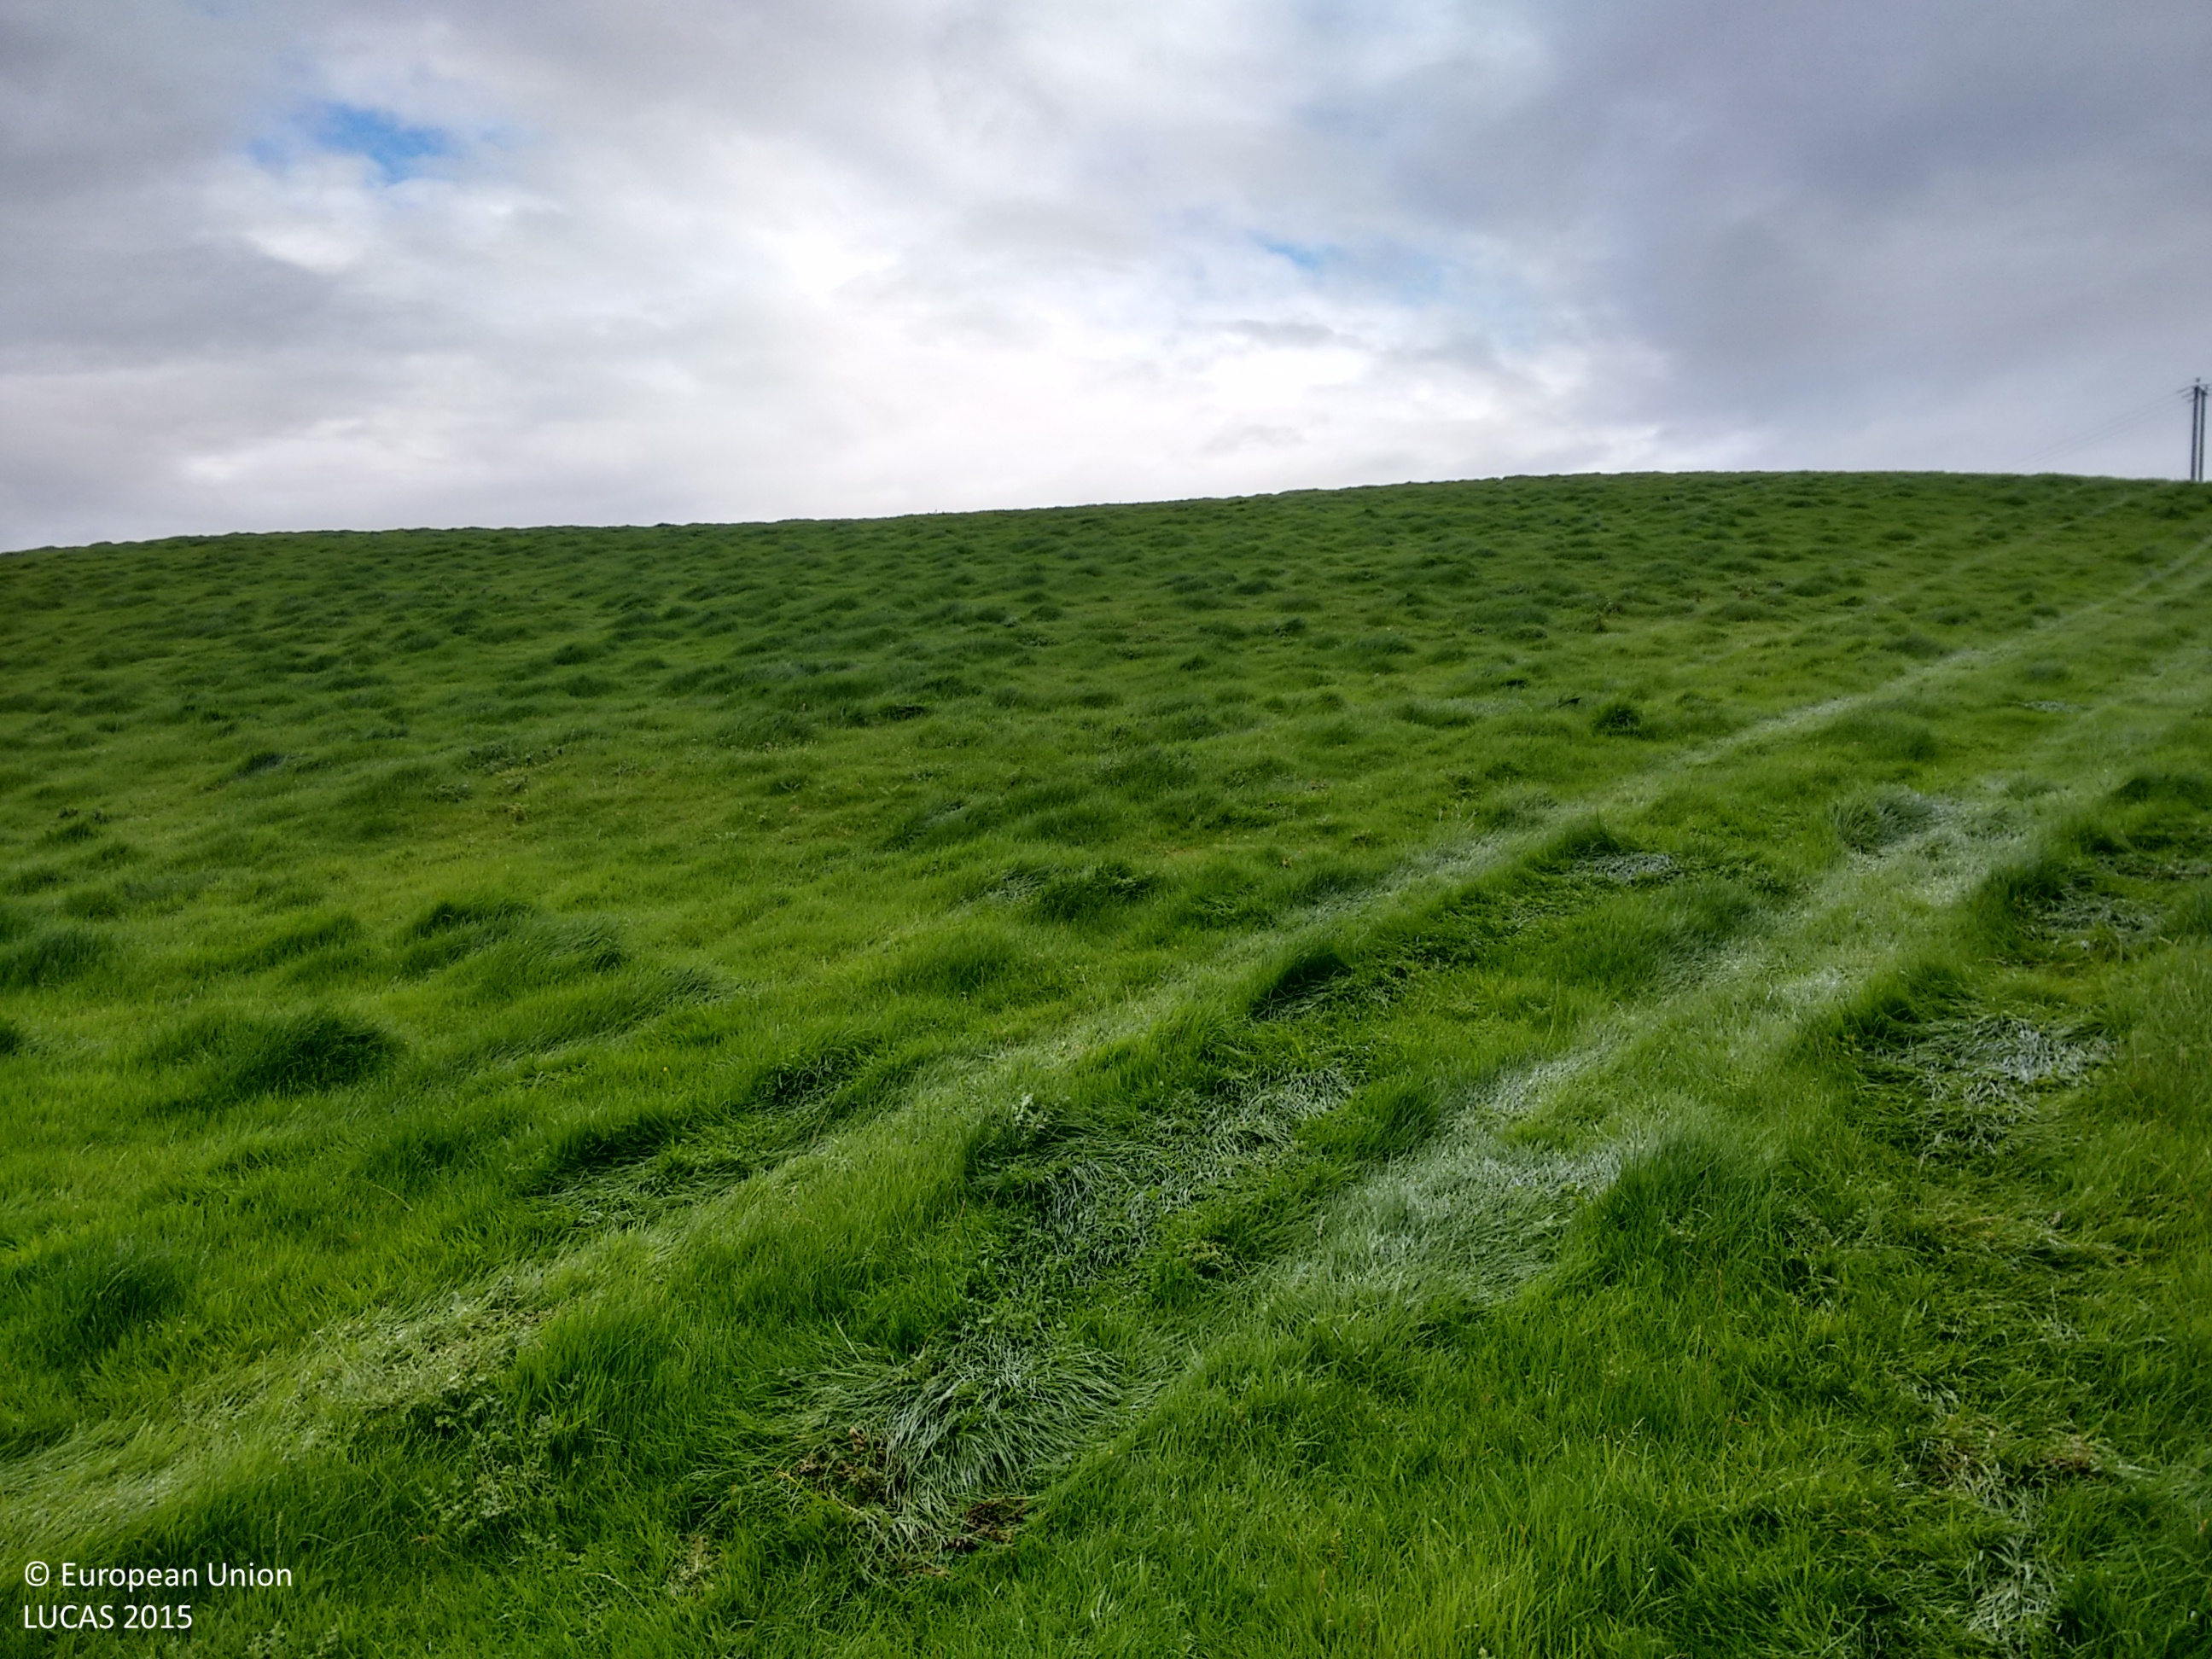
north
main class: Grassland
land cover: Grassland with sparse tree/shrub cover
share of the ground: > 75 %
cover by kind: herbaceous plants 95 %, broadleaved forest trees 5 %
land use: Agriculture (excluding fallow land and kitchen gardens)
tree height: > 5 m
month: September
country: GB
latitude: 52.5358
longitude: -3.3049
